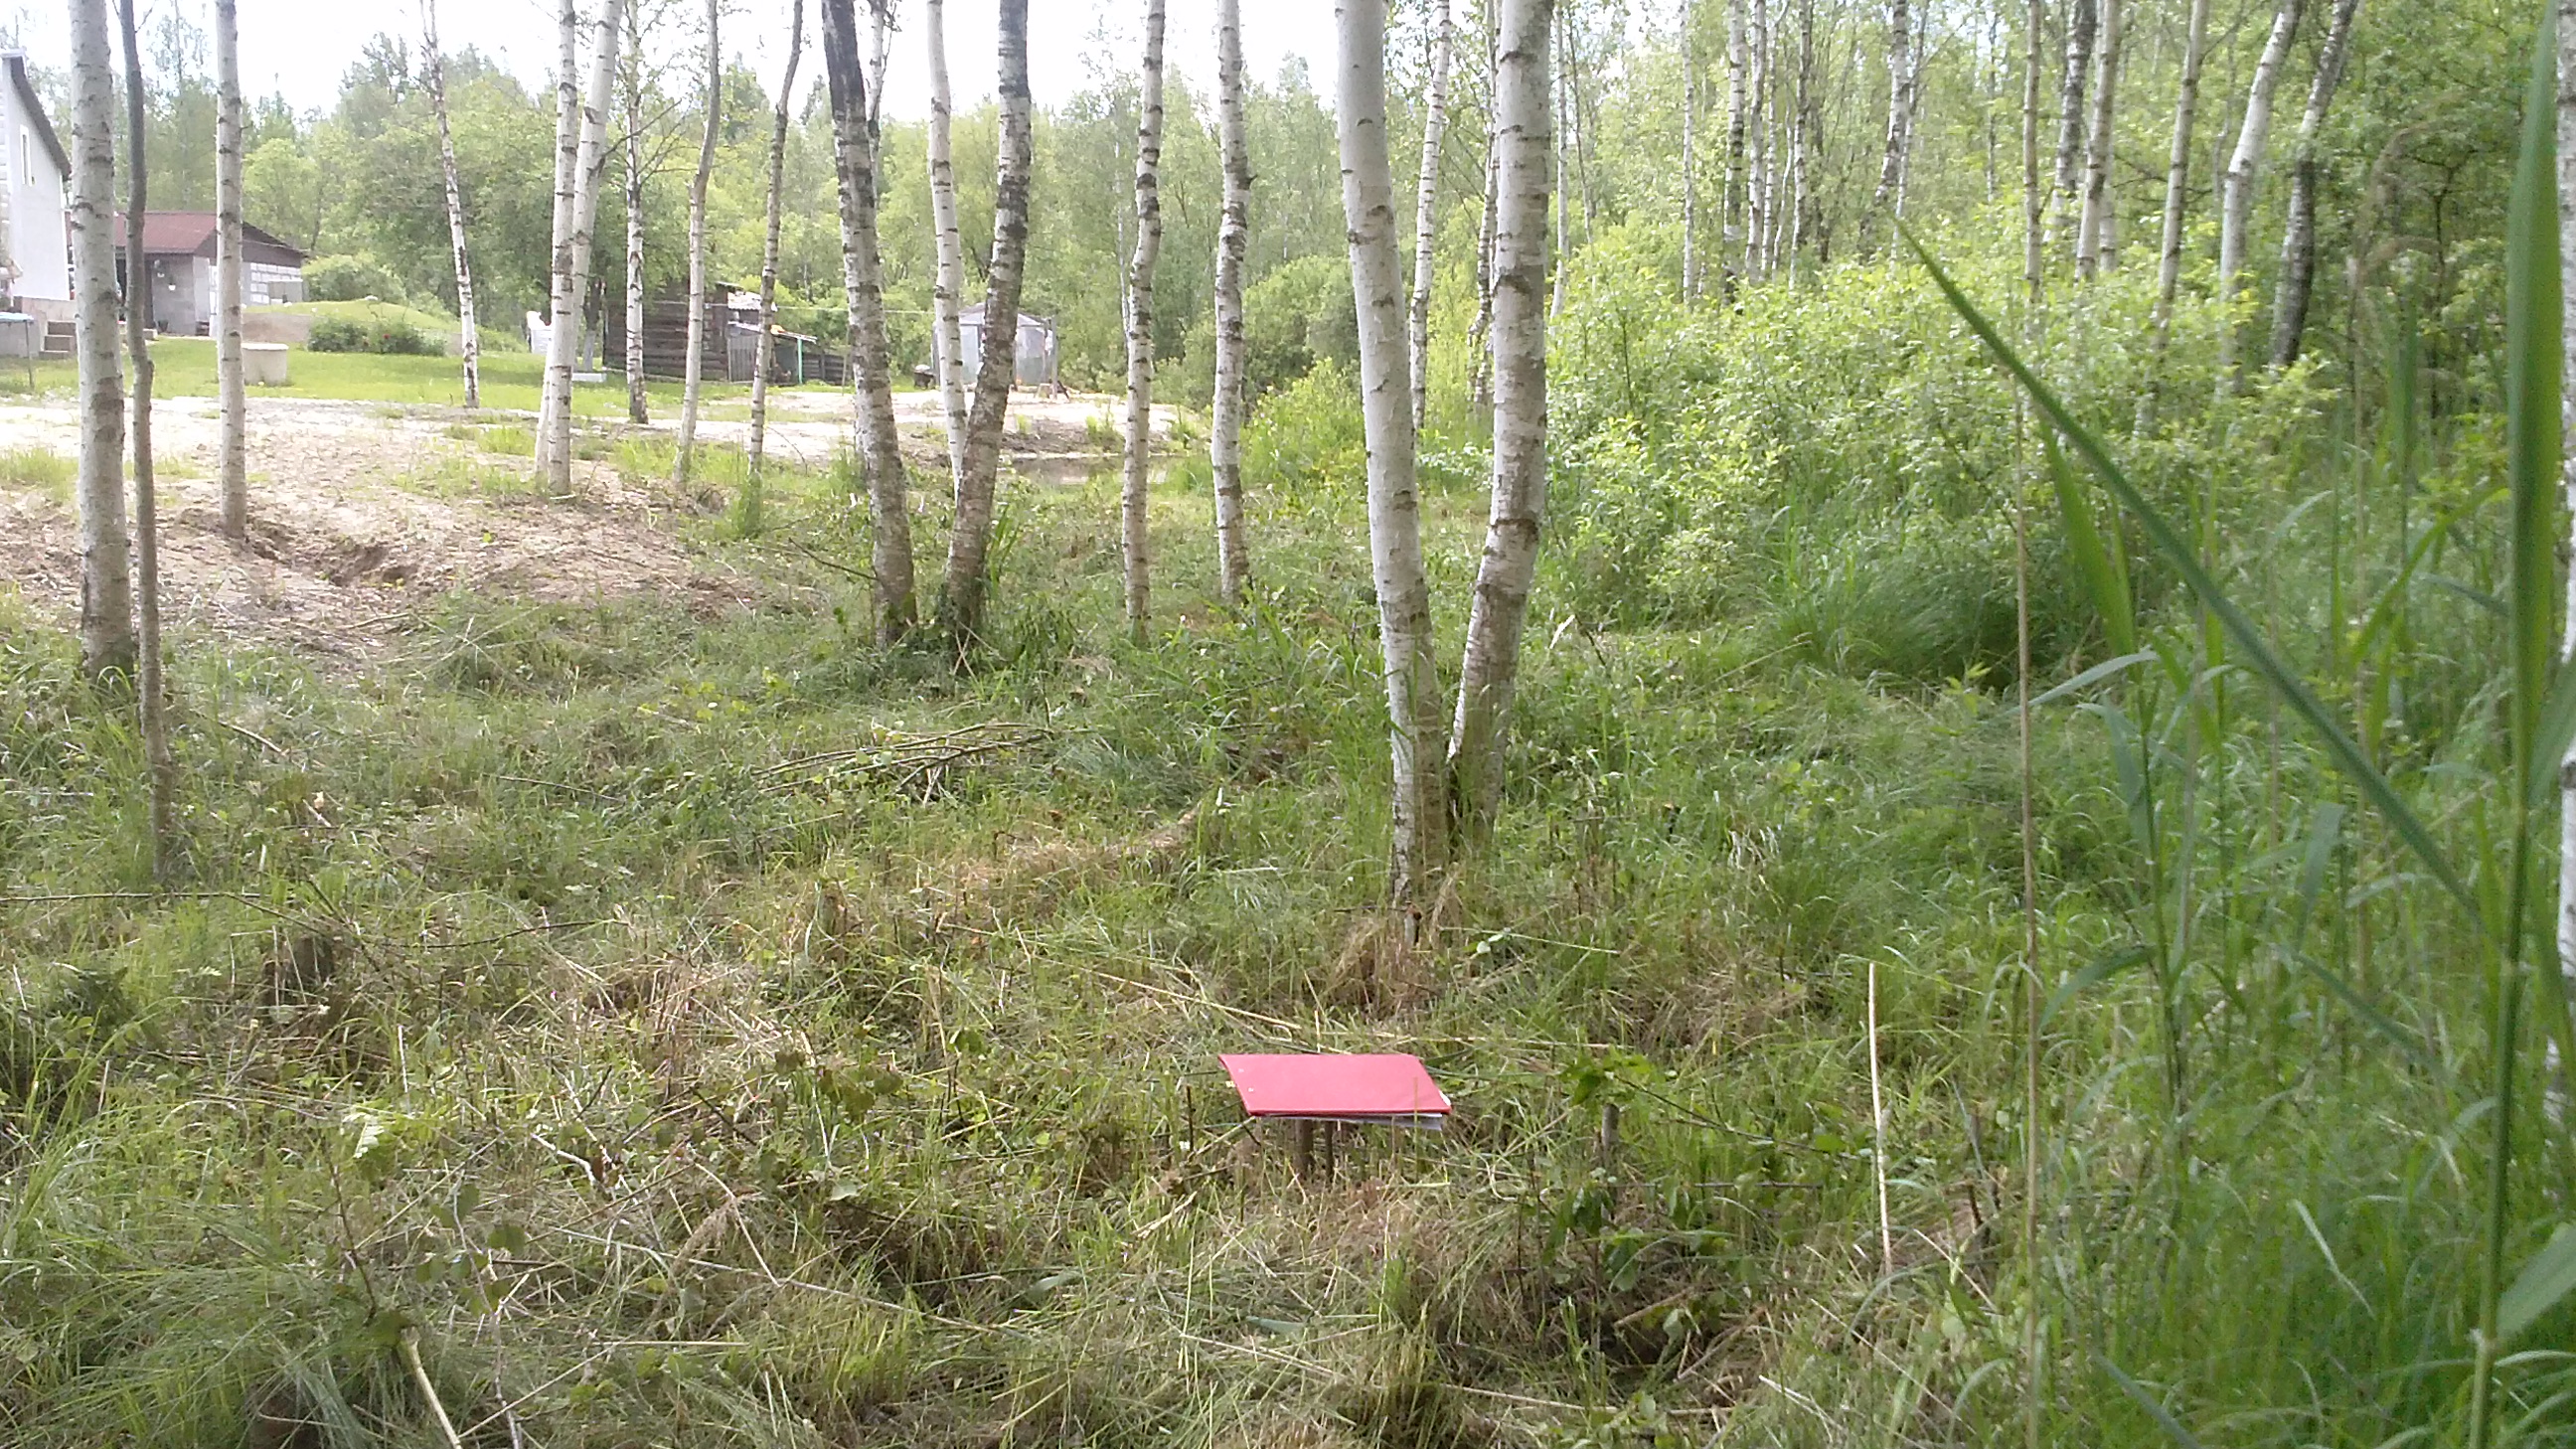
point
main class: Woodland
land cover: Broadleaved woodland
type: non-riverine alder, birch or aspen forest
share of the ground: 50 - 75 %
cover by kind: broadleaved forest trees 70 %, shrubs 20 %, herbaceous plants 10 %
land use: Forestry
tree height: > 5 m
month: June
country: LV
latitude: 56.4745
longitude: 27.3001
